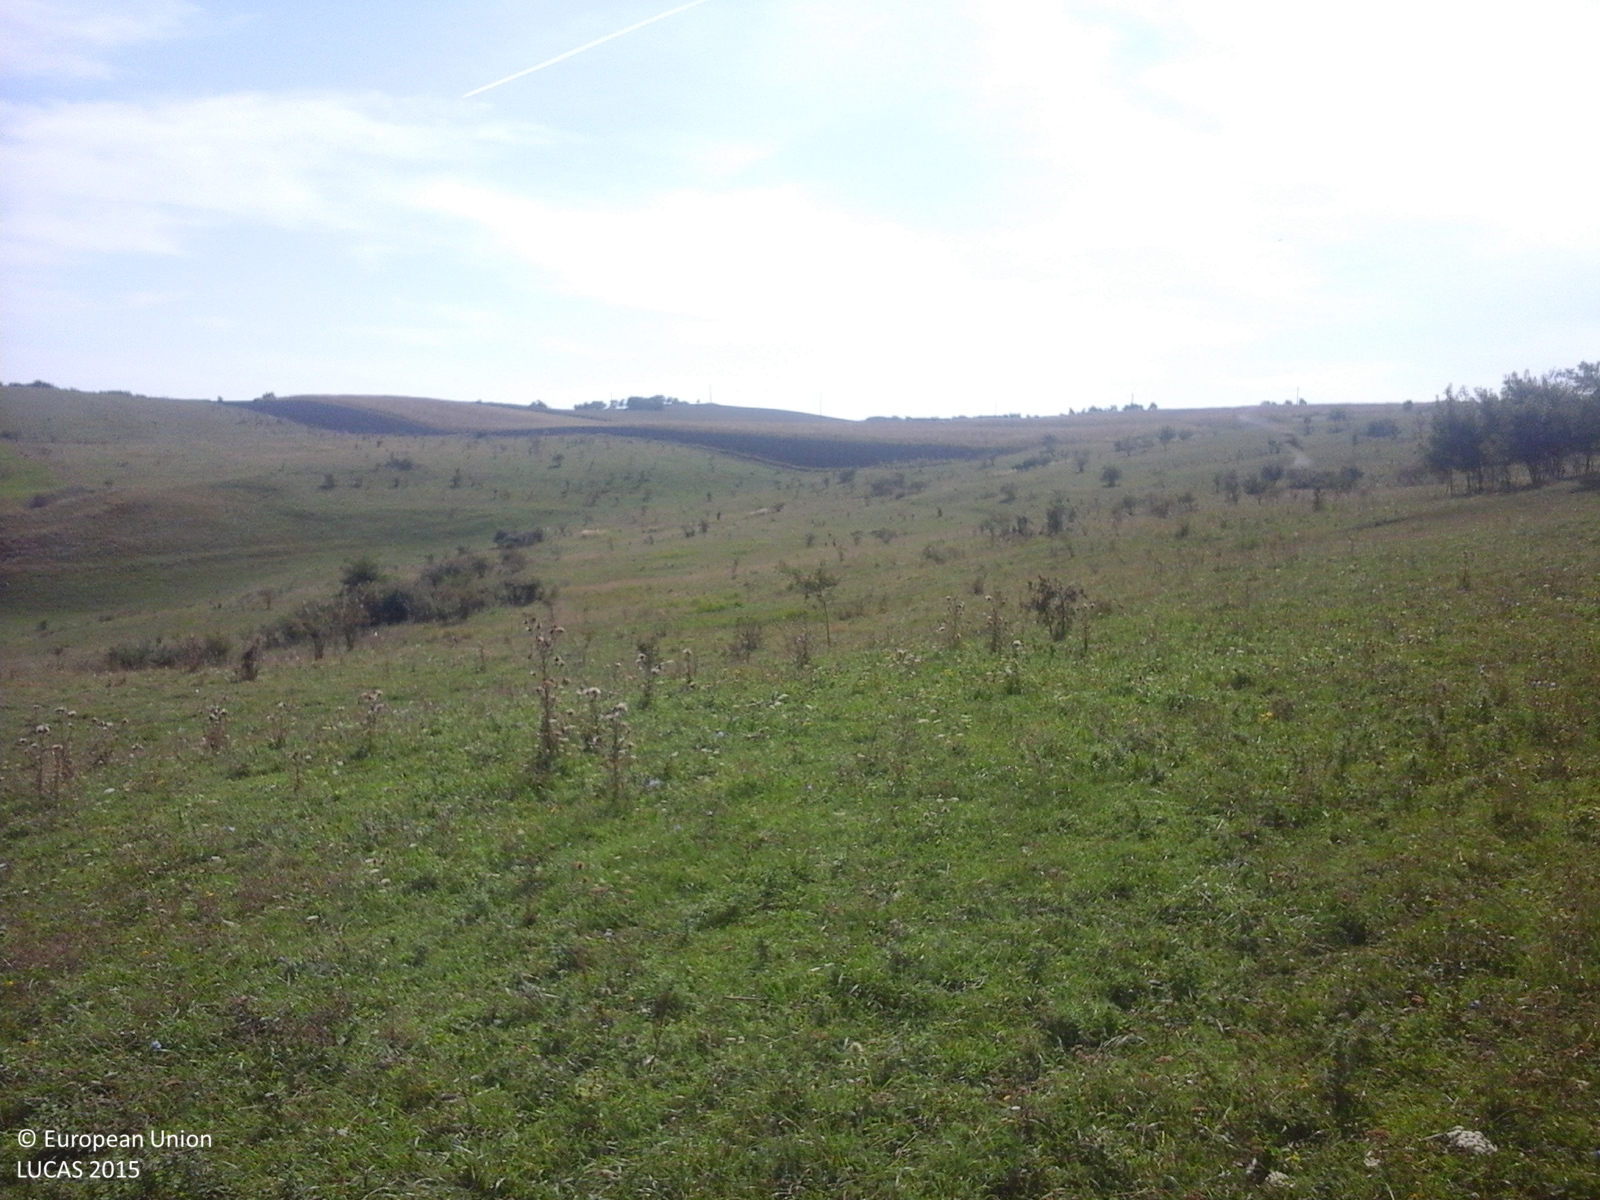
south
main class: Grassland
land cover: Grassland without tree/shrub cover
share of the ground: > 75 %
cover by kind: herbaceous plants 100 %
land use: Agriculture (excluding fallow land and kitchen gardens)
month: September
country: RO
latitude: 46.7053
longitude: 23.8481
